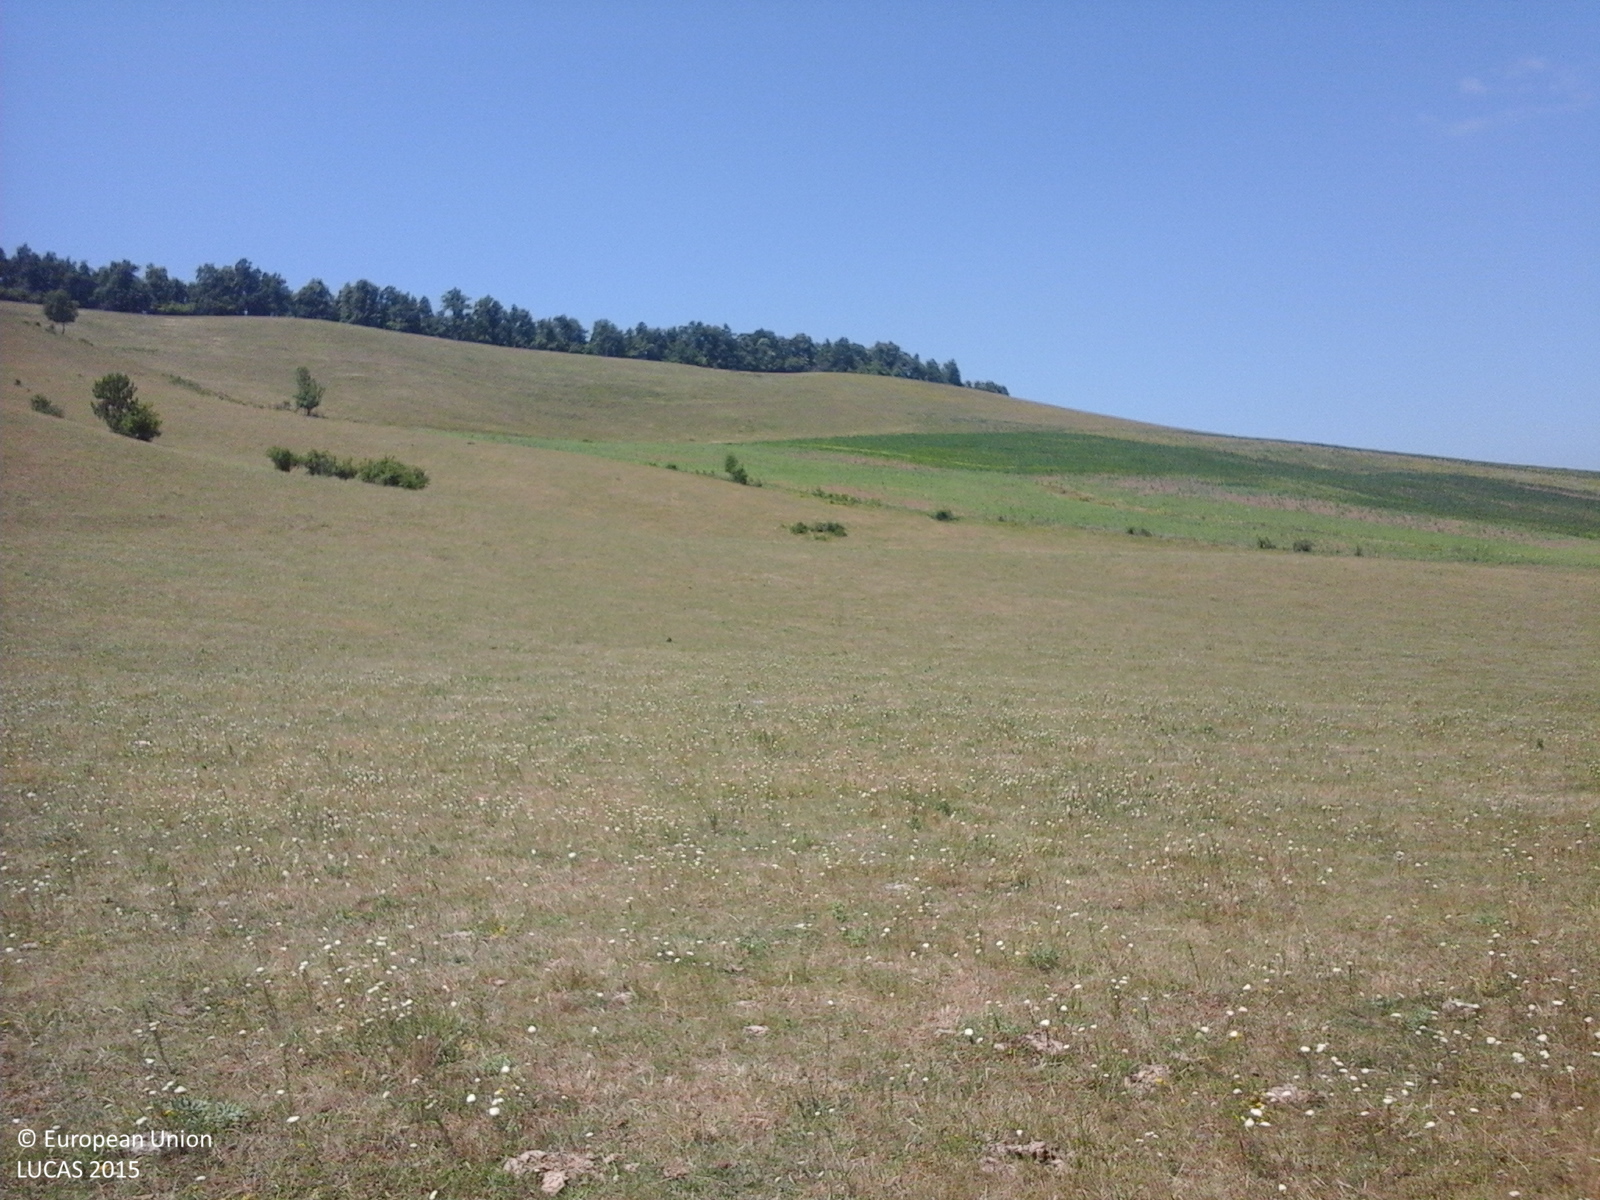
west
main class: Grassland
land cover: Grassland without tree/shrub cover
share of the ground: > 75 %
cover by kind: herbaceous plants 100 %
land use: Agriculture (excluding fallow land and kitchen gardens)
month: June
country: RO
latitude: 46.8749
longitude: 27.8777
